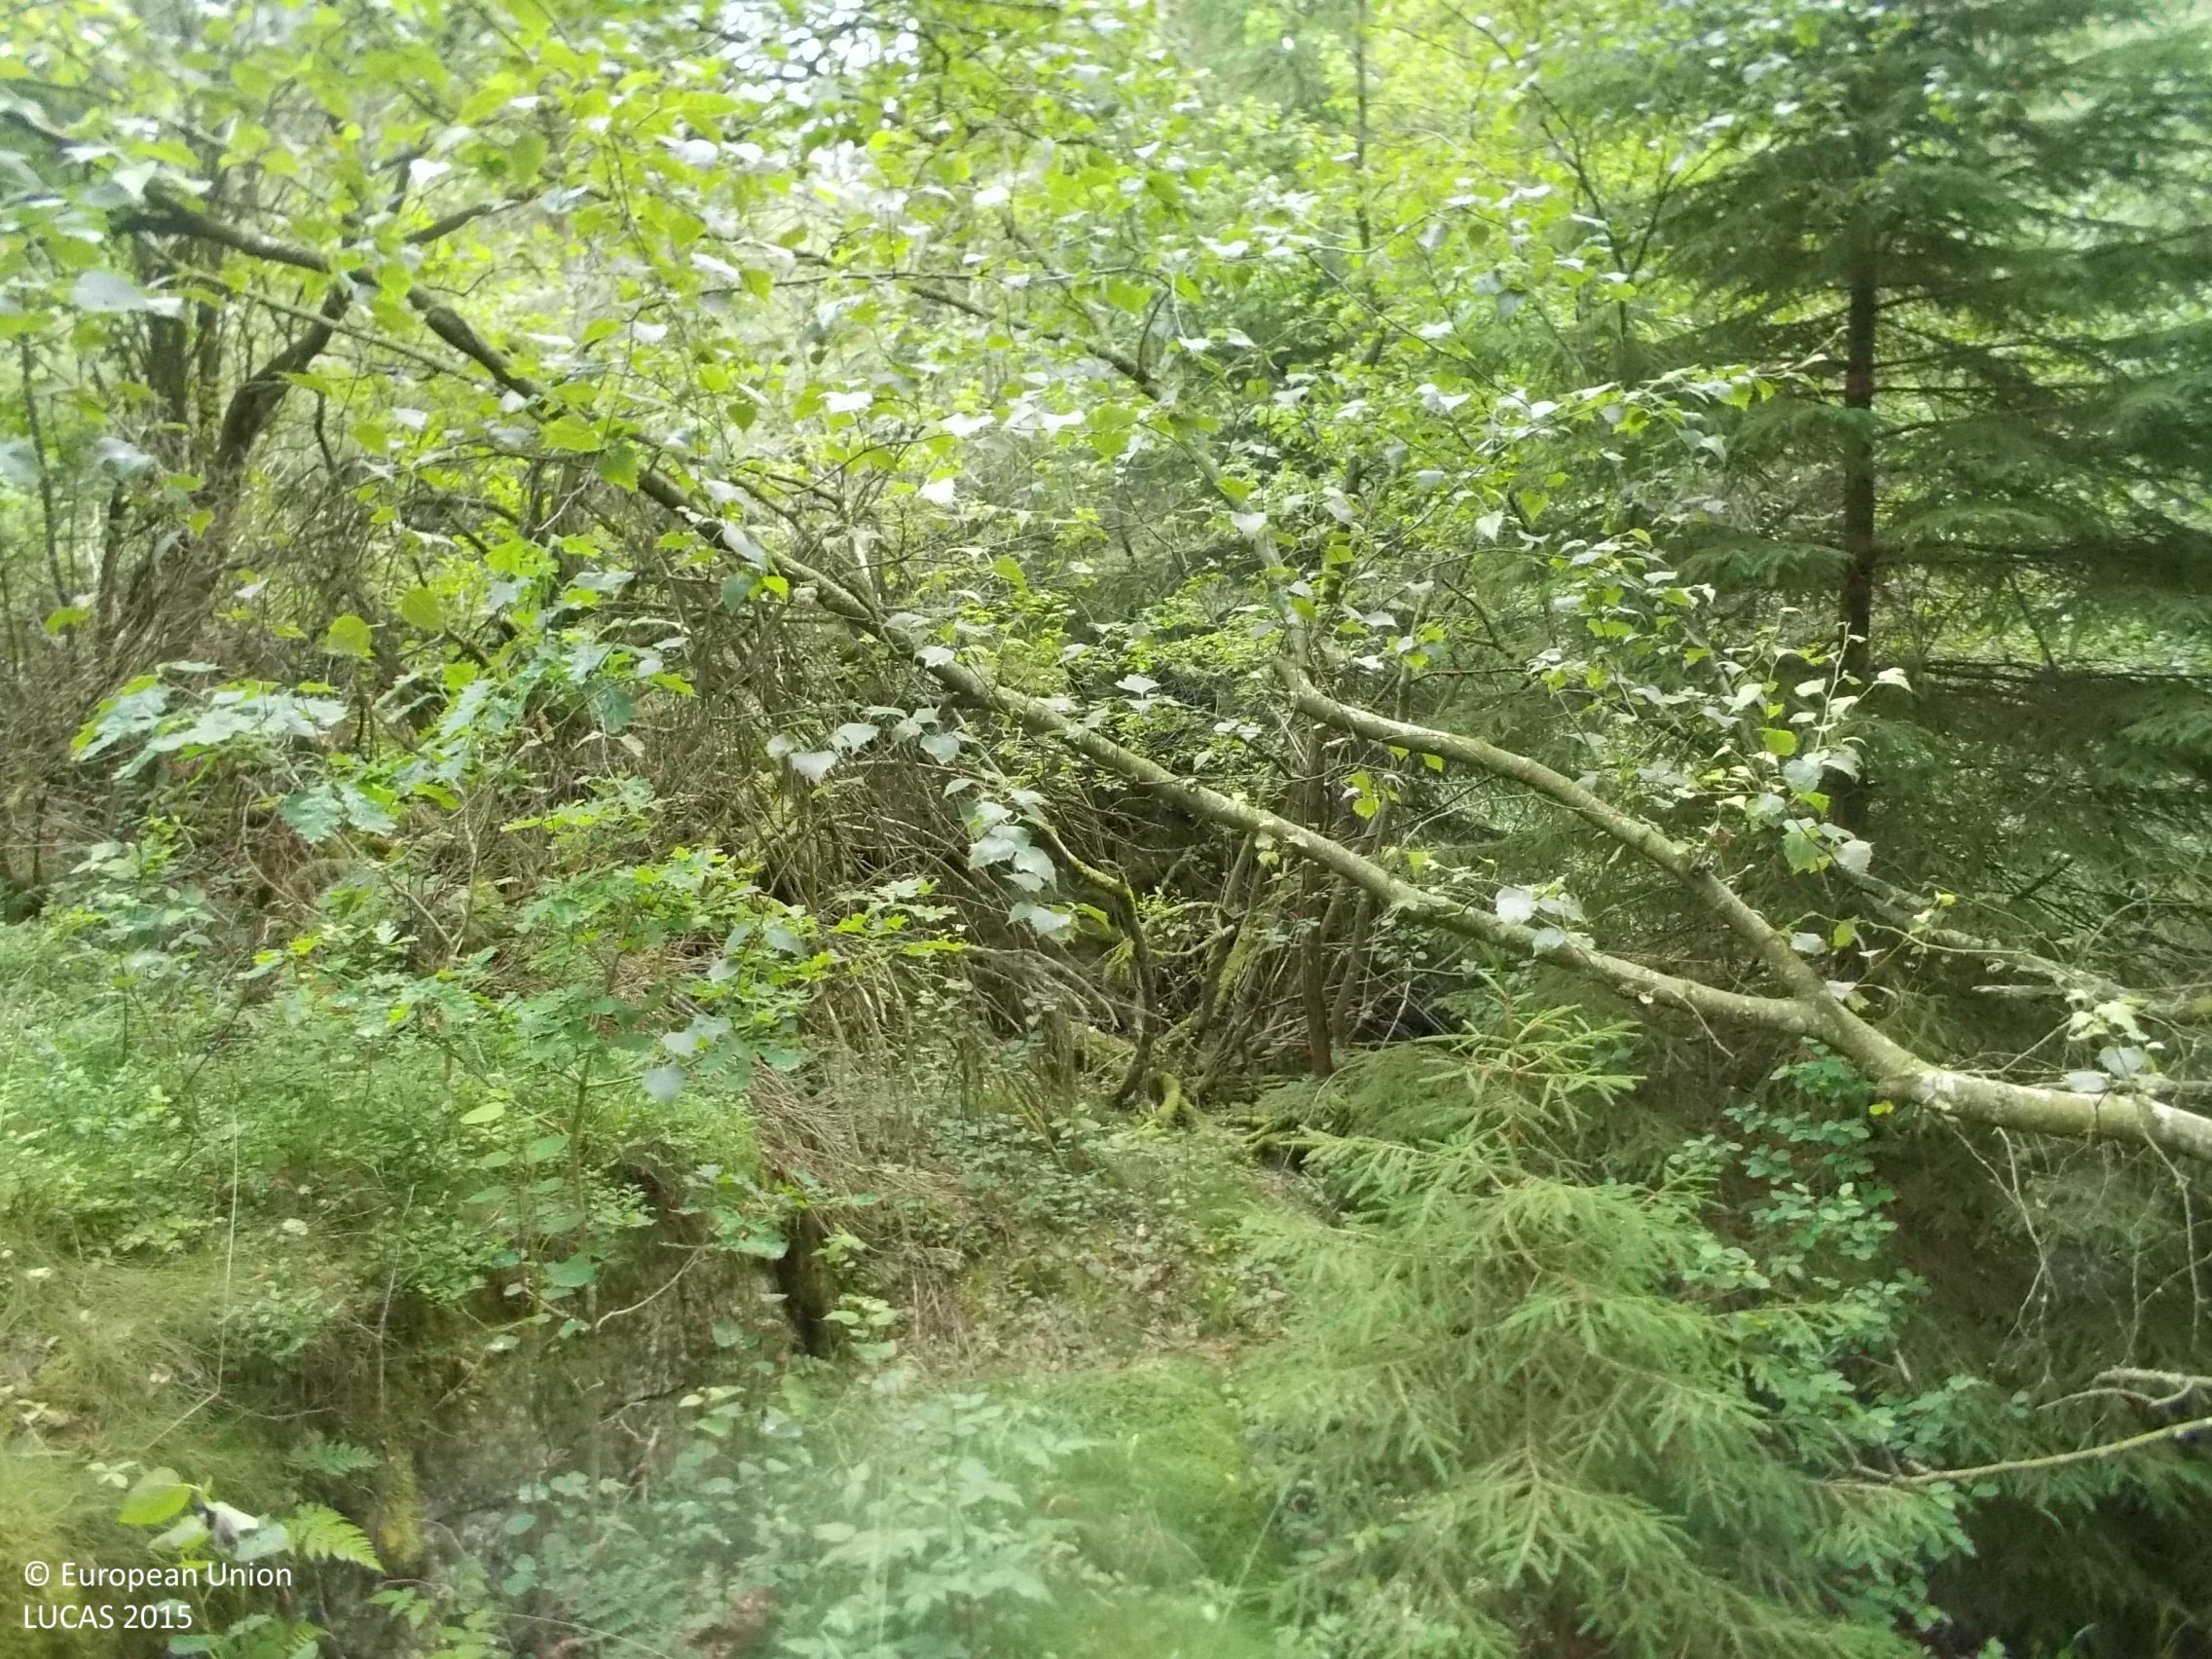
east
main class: Woodland
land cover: Broadleaved woodland
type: hemiboreal forest and nemoral coniferous forest and mixed broadleaved-coniferous forest
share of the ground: > 75 %
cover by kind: broadleaved forest trees 80 %, herbaceous plants 10 %, shrubs 5 %, lichens and mosses 5 %
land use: Forestry
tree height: > 5 m
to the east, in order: Broadleaved woodland; Pine dominated coniferous woodland
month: July
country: SE
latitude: 57.2834
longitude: 12.2363
